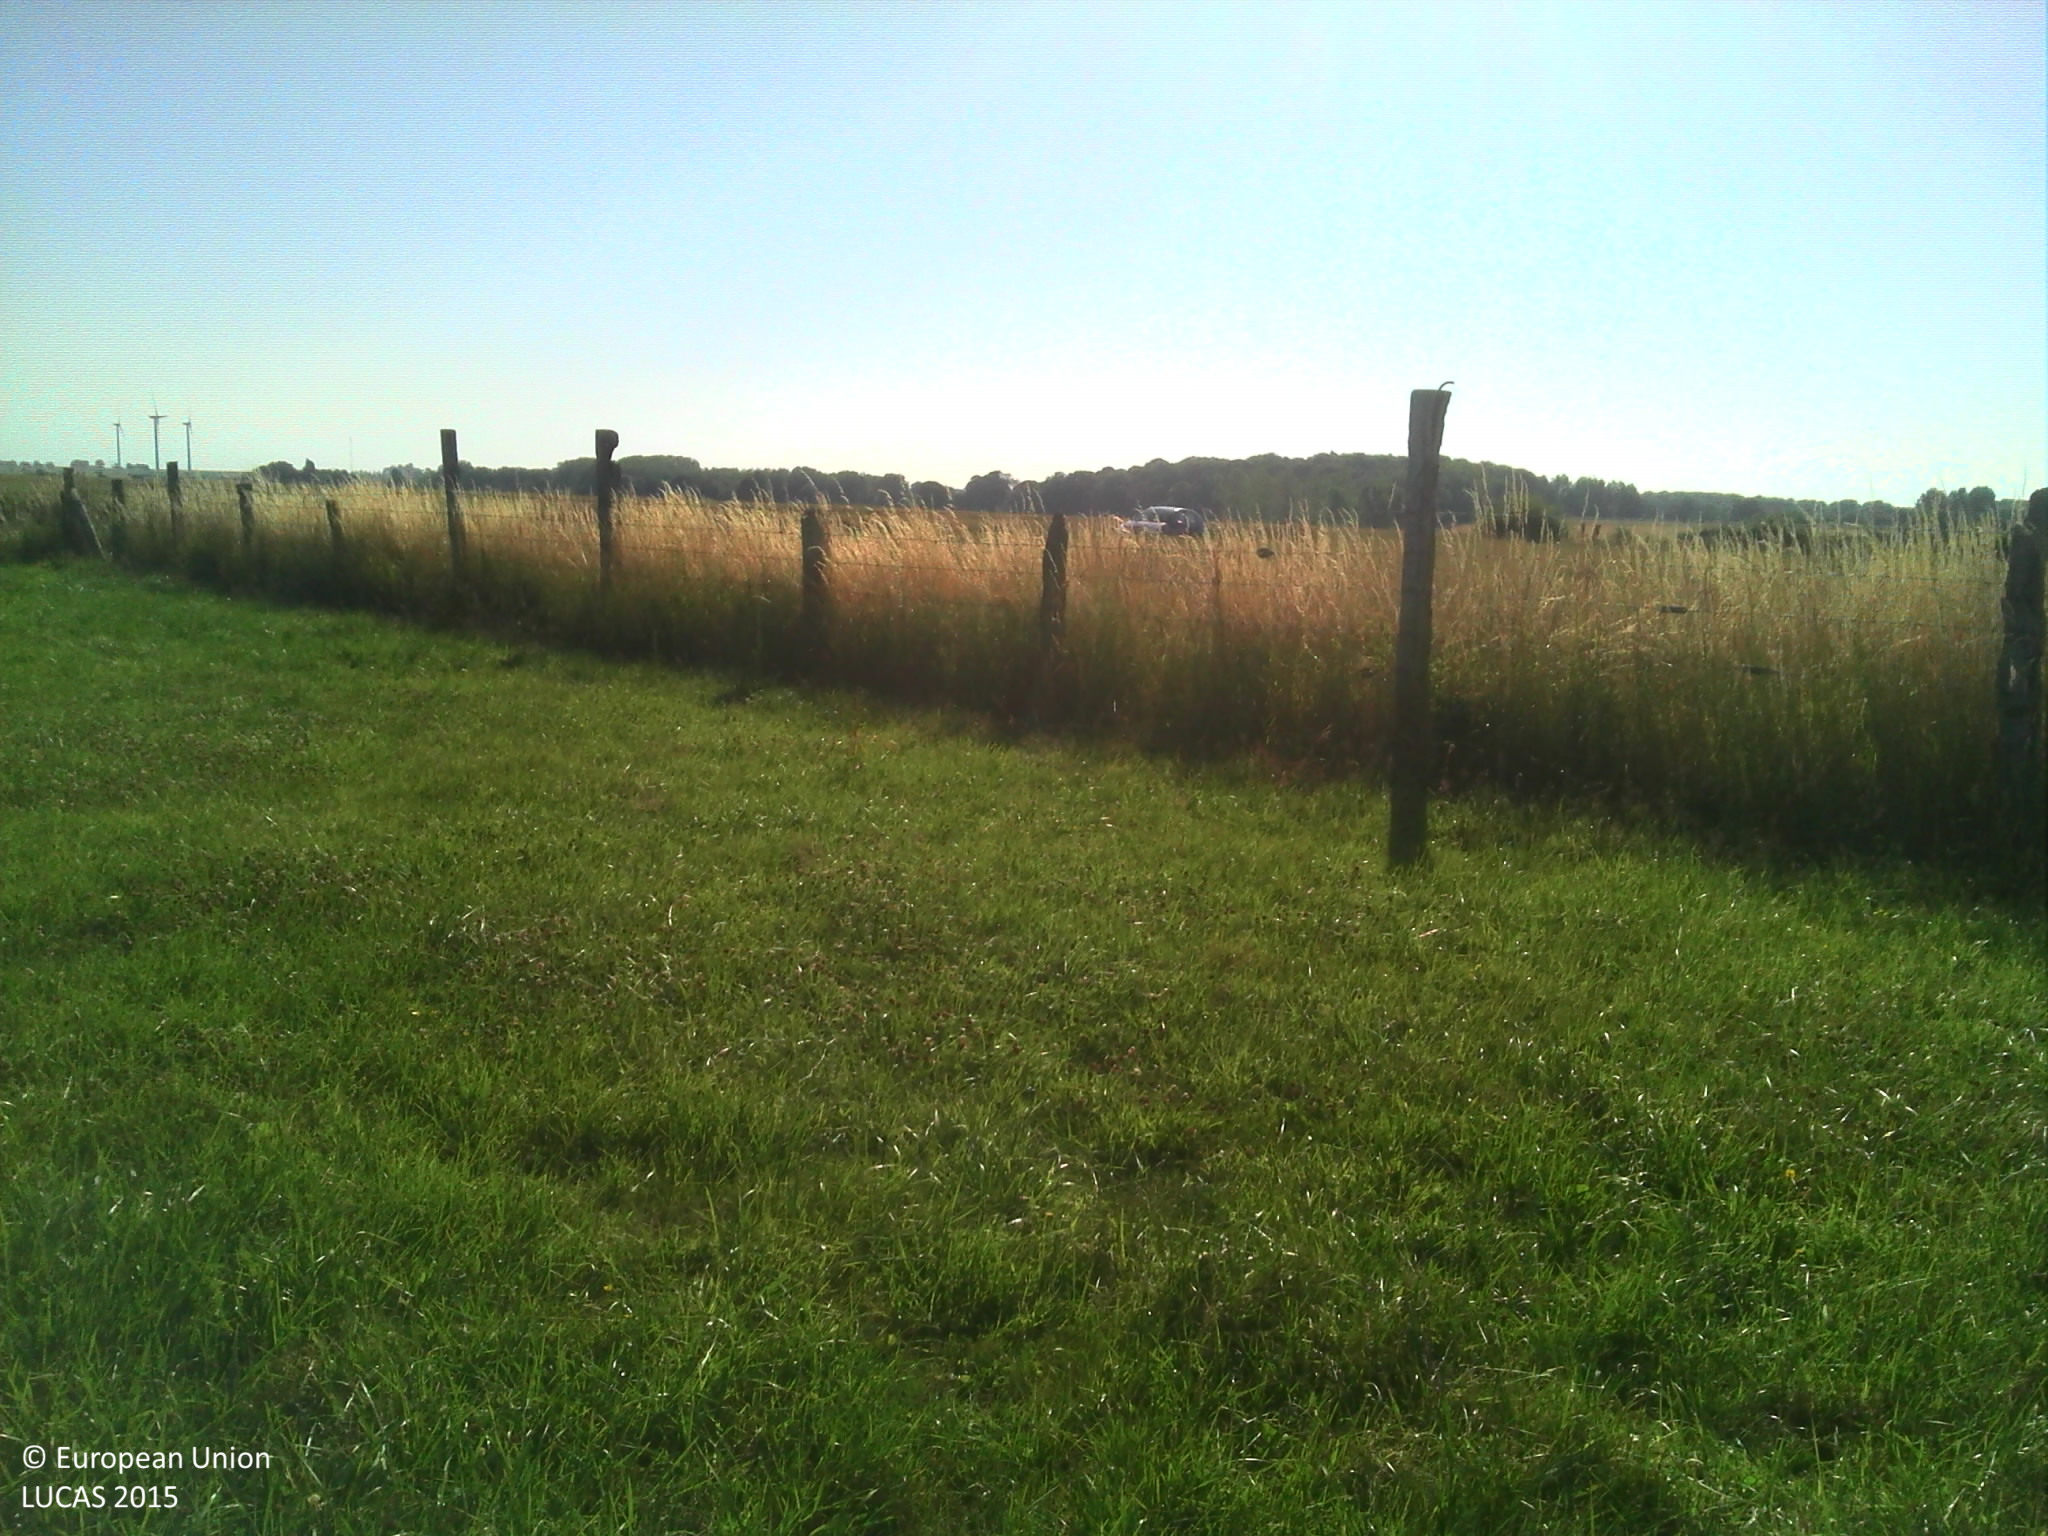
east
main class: Grassland
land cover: Grassland without tree/shrub cover
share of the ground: > 75 %
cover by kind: herbaceous plants 100 %
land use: Agriculture (excluding fallow land and kitchen gardens)
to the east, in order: Grassland without tree/shrub cover; Fences; Grass margins; Common wheat; Grass margins; Tracks; Grass margins; Common wheat
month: July
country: FR
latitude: 49.9727
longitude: 1.7143
